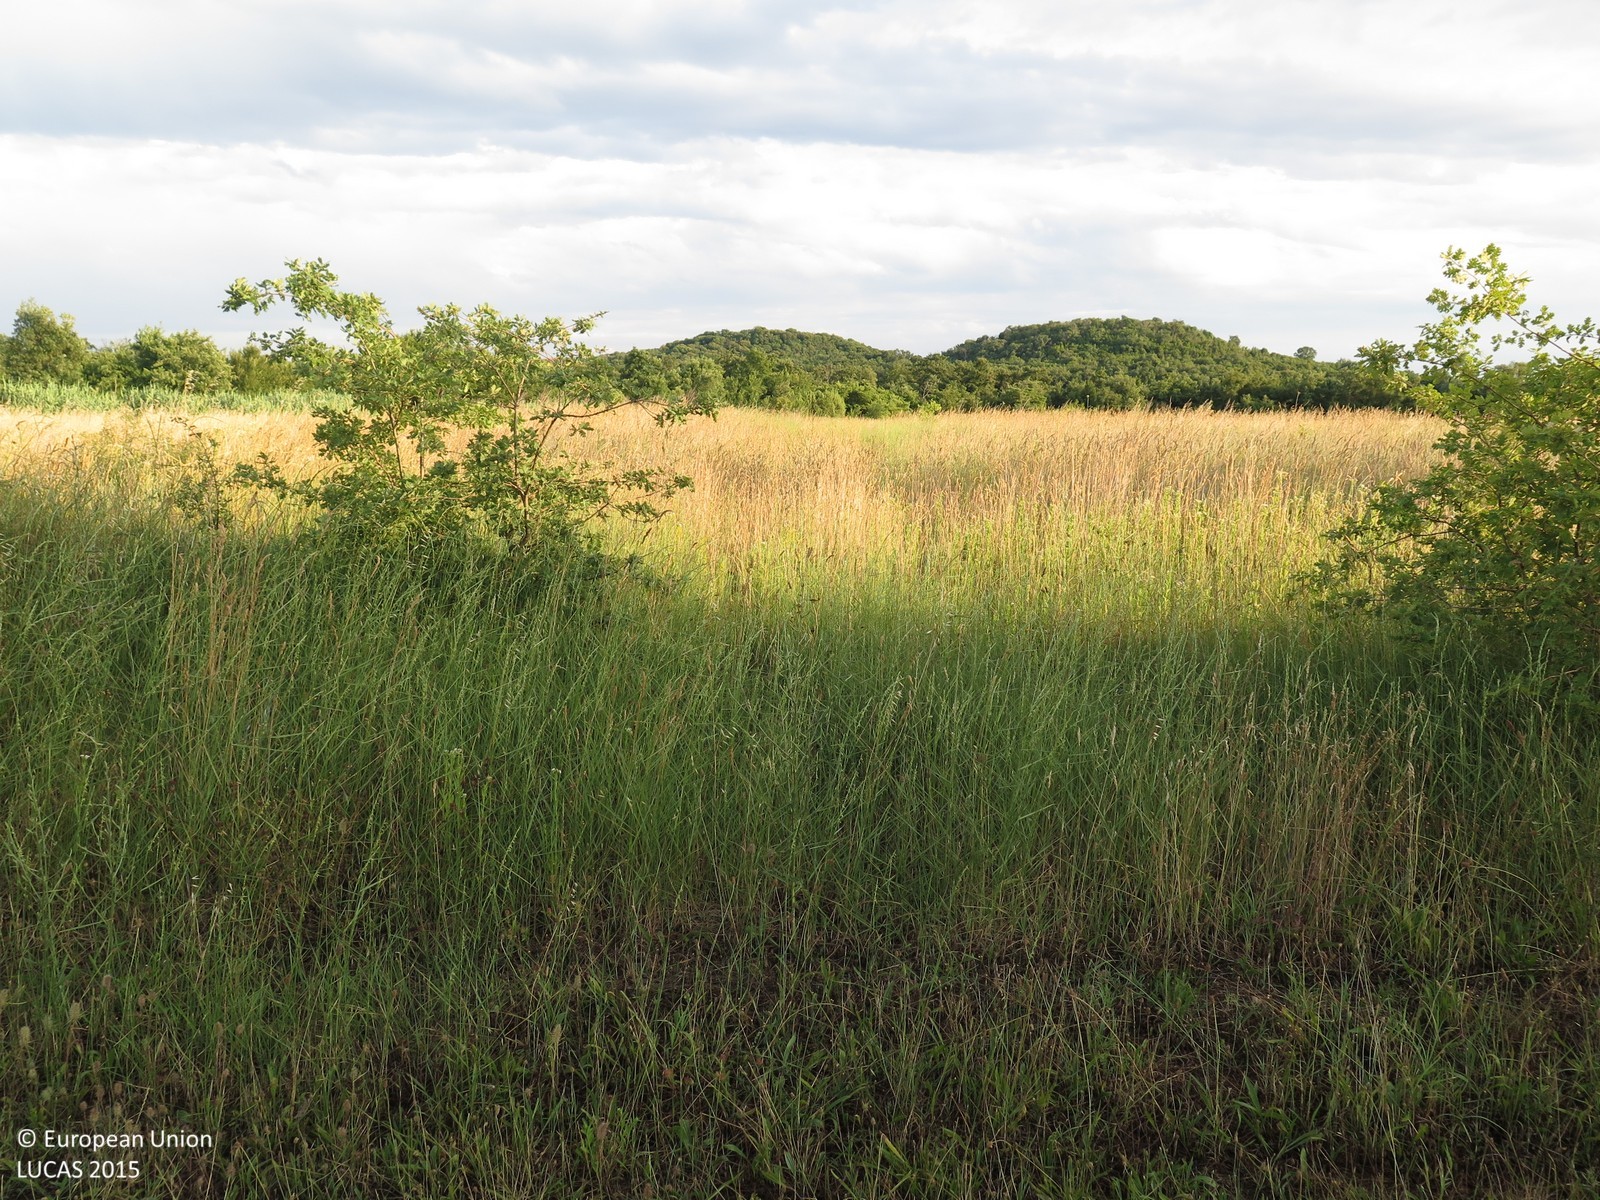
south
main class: Grassland
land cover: Grassland without tree/shrub cover
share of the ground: > 75 %
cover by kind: herbaceous plants 100 %
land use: Agriculture (excluding fallow land and kitchen gardens)
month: June
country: HR
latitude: 45.2069
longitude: 13.6488
